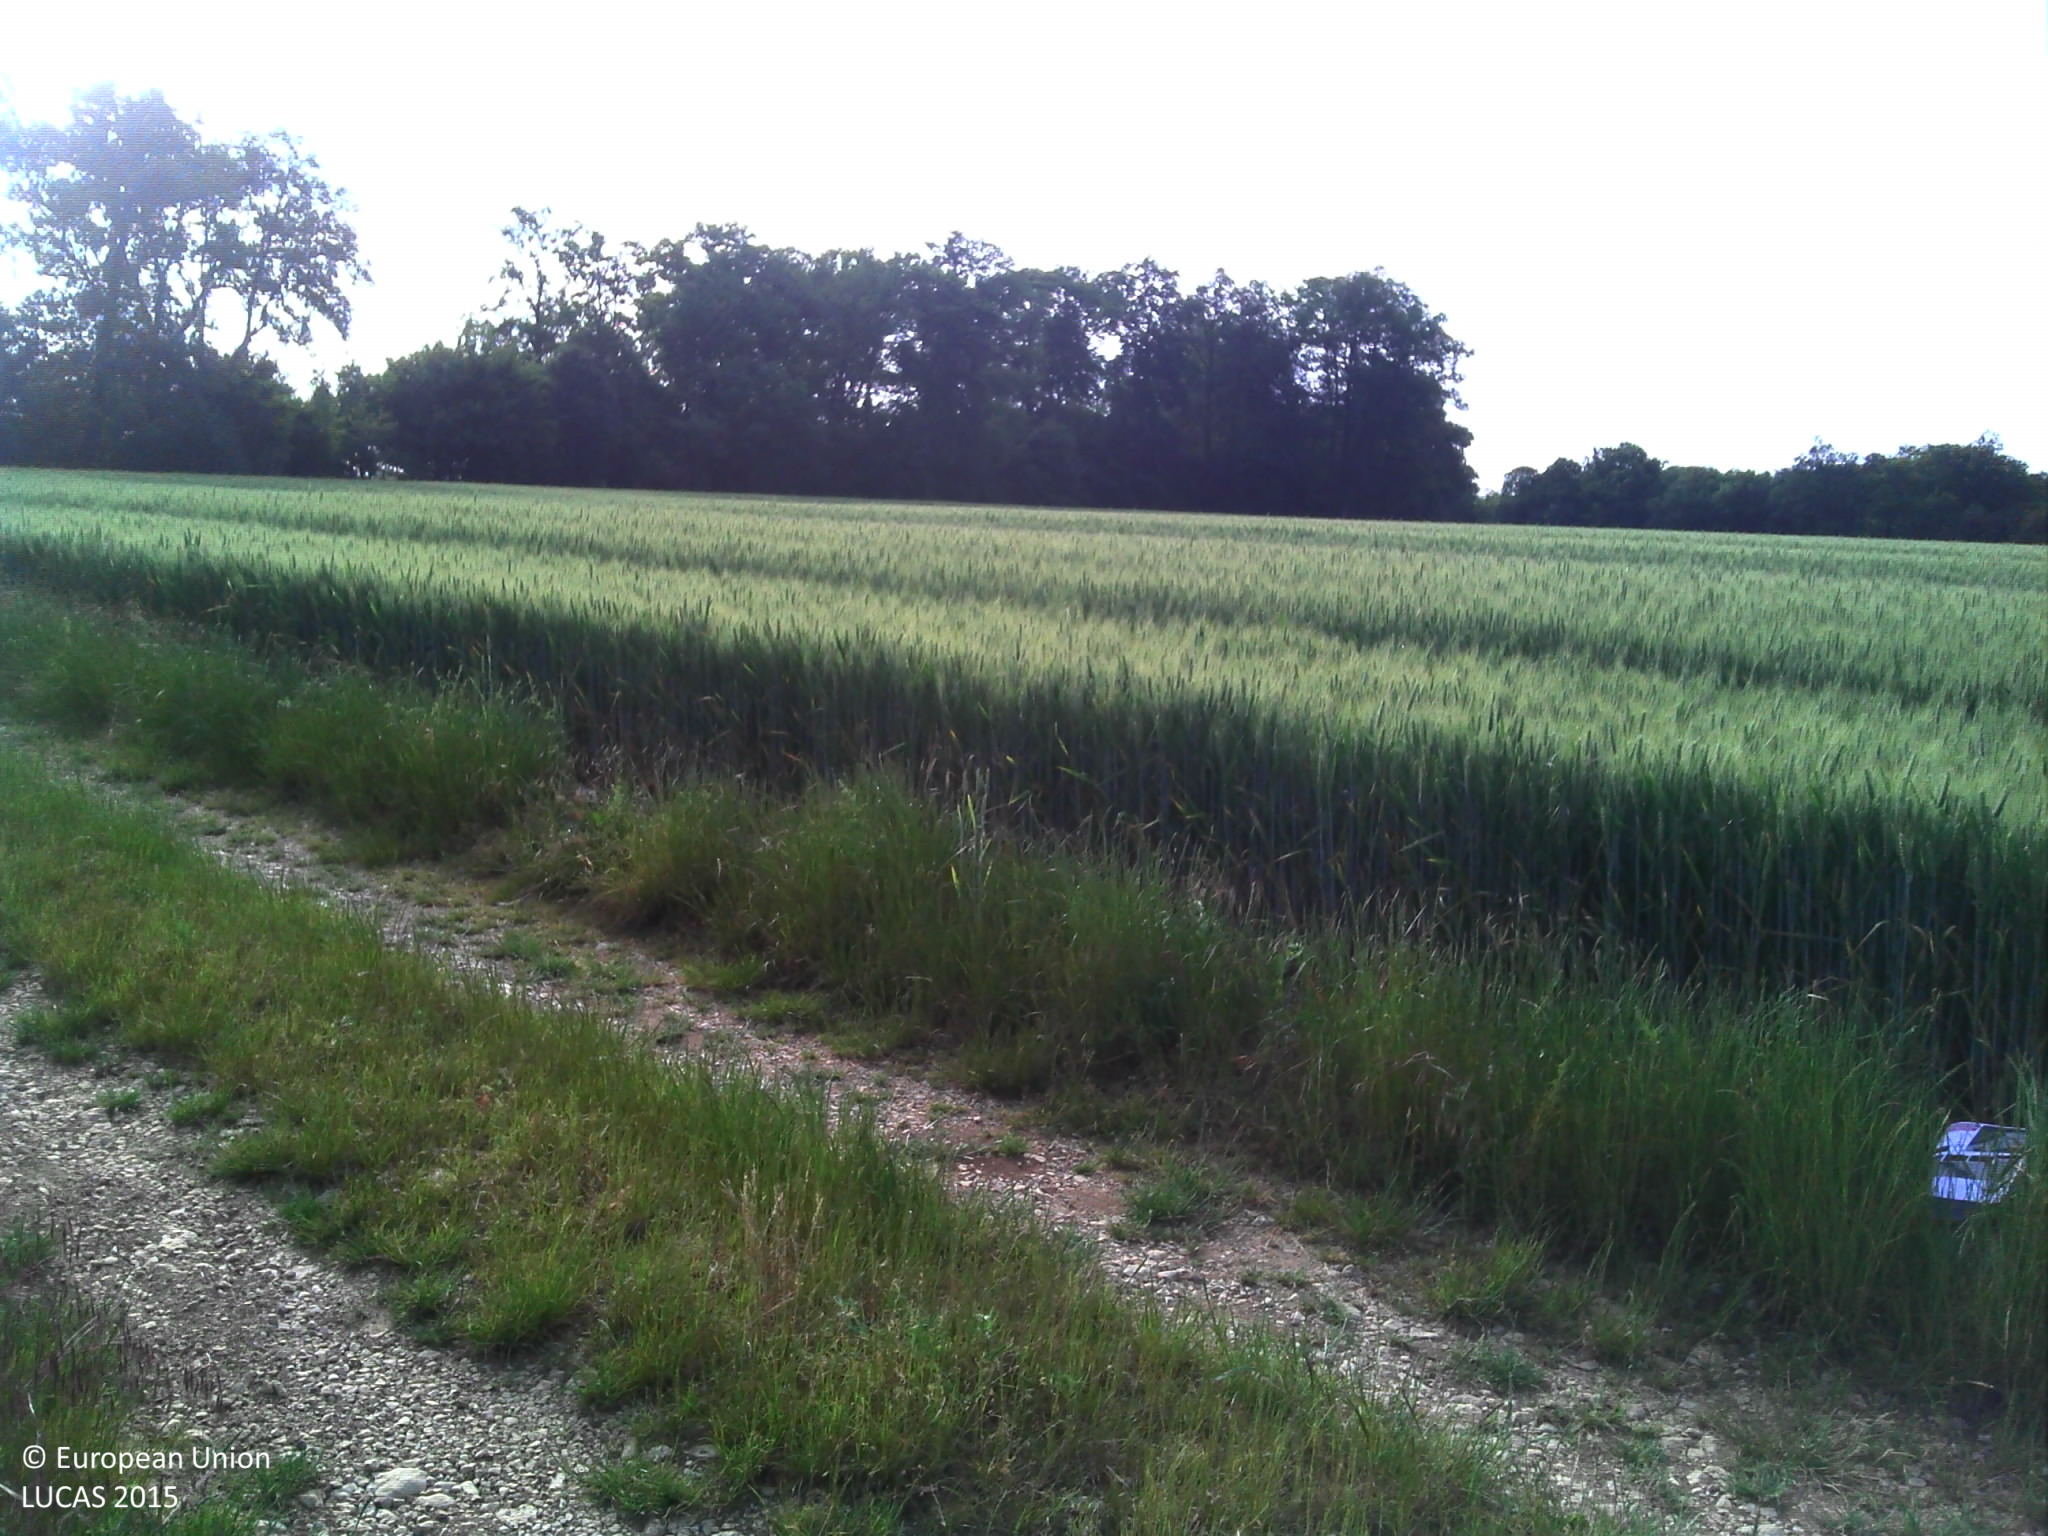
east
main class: Cropland
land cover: Common wheat
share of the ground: > 75 %
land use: Agriculture (excluding fallow land and kitchen gardens)
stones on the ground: 10 - 25 %
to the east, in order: Common wheat; Grass margins; Tracks; Grass margins; Common wheat; Grass margins; Broadleaved woodland; Tracks; Broadleaved woodland; Grass margins; Common wheat
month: June
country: FR
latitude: 48.4782
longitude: 5.1693
